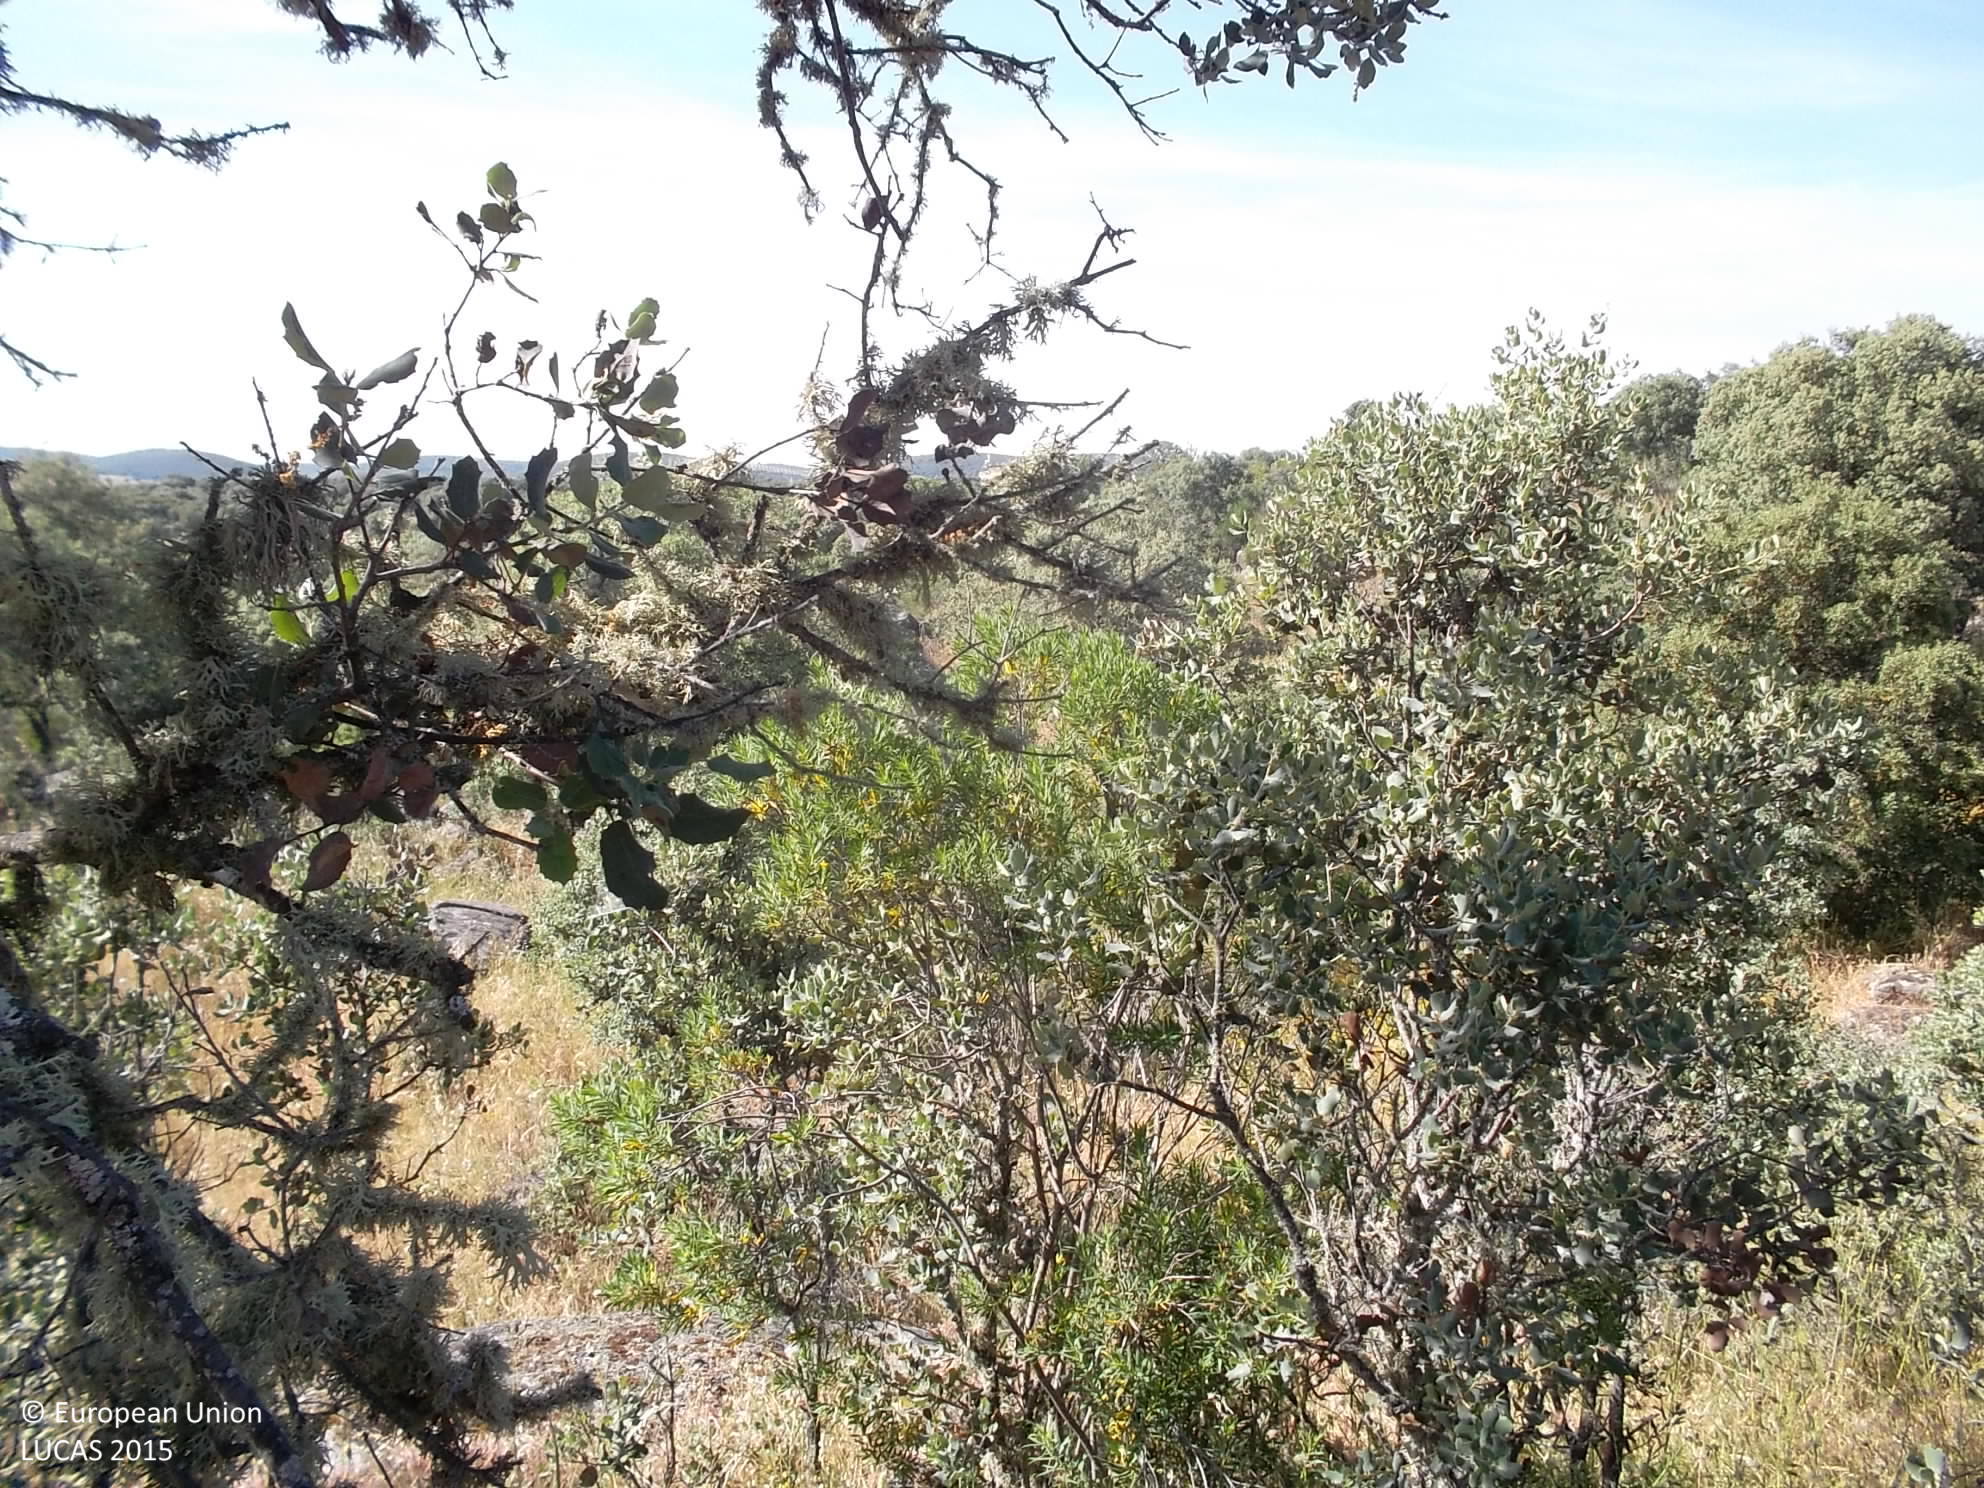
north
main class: Woodland
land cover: Broadleaved woodland
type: broadleaved evergreen forest
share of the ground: 25 - 50 %
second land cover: Shrubland without tree cover
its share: 50 - 75 %
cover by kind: broadleaved forest trees 40 %, shrubs 40 %, herbaceous plants 20 %
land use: Forestry
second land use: Agriculture (excluding fallow land and kitchen gardens)
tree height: < 5 m
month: May
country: ES
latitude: 38.7773
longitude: -4.5171
